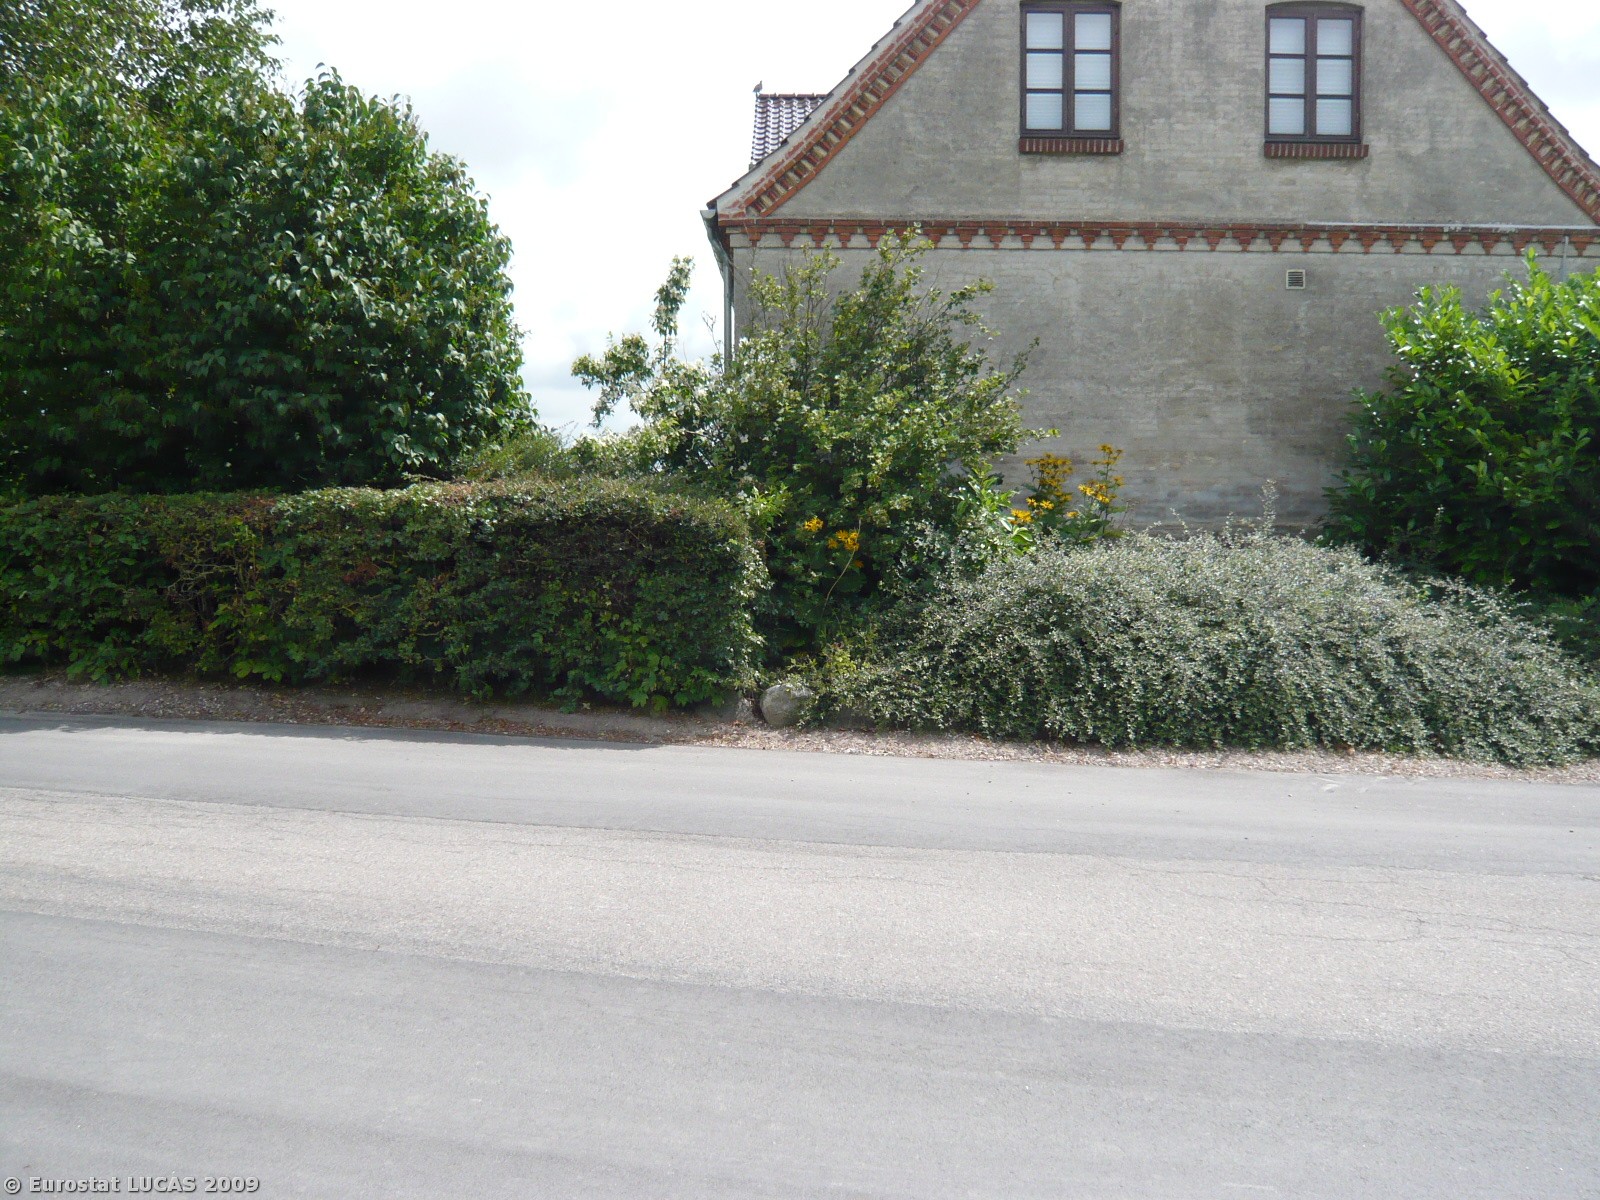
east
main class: Grassland
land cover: Grassland without tree/shrub cover
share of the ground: > 75 %
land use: Agriculture (excluding fallow land and kitchen gardens)
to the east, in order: Grassland without tree/shrub cover; Paved roads, cycling and walking lanes; Artificial constructions in urban areas; Barley
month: July
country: DK
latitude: 55.3538
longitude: 11.3395
